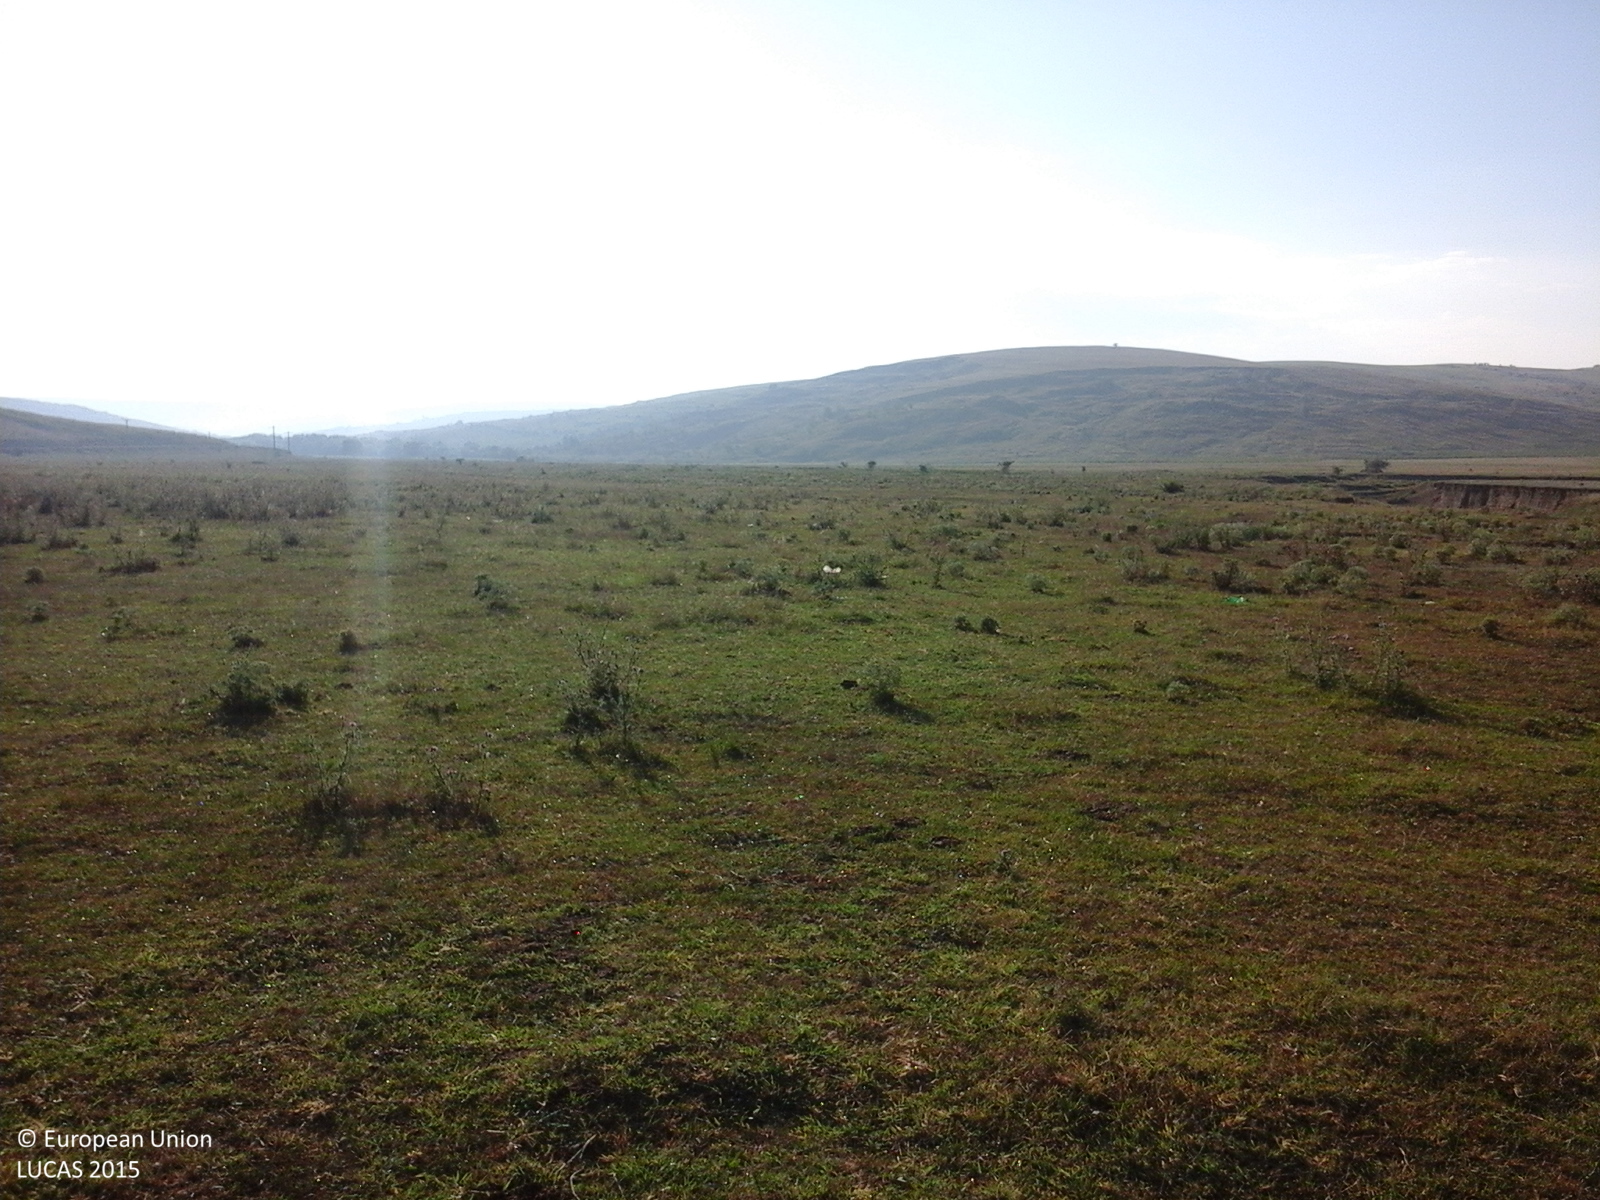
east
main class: Grassland
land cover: Grassland without tree/shrub cover
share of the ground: > 75 %
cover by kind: herbaceous plants 100 %
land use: Agriculture (excluding fallow land and kitchen gardens)
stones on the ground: < 10 %
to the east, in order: Grassland without tree/shrub cover; Rivers and streams; Grassland without tree/shrub cover
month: July
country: RO
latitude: 46.1827
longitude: 27.7210
